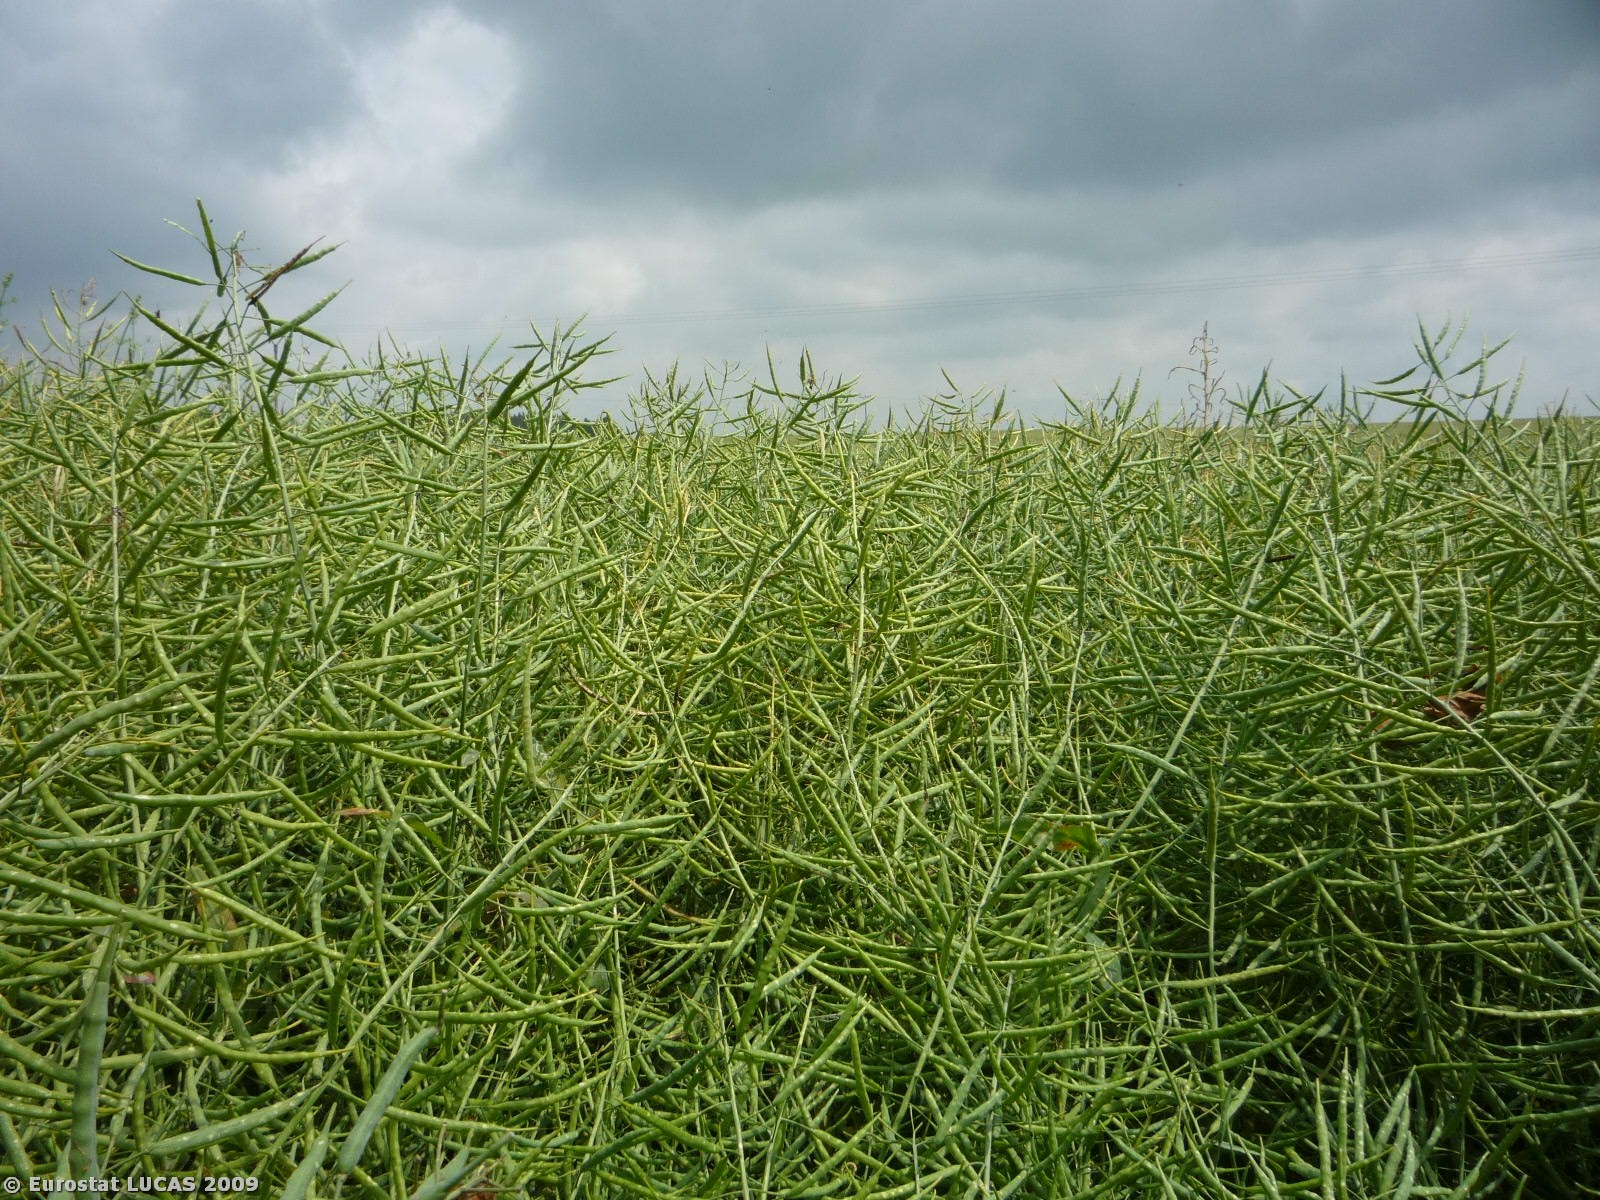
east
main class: Cropland
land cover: Rape and turnip rape
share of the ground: > 75 %
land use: Agriculture (excluding fallow land and kitchen gardens)
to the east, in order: Rape and turnip rape
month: June
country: CZ
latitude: 49.9649
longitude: 15.0355
